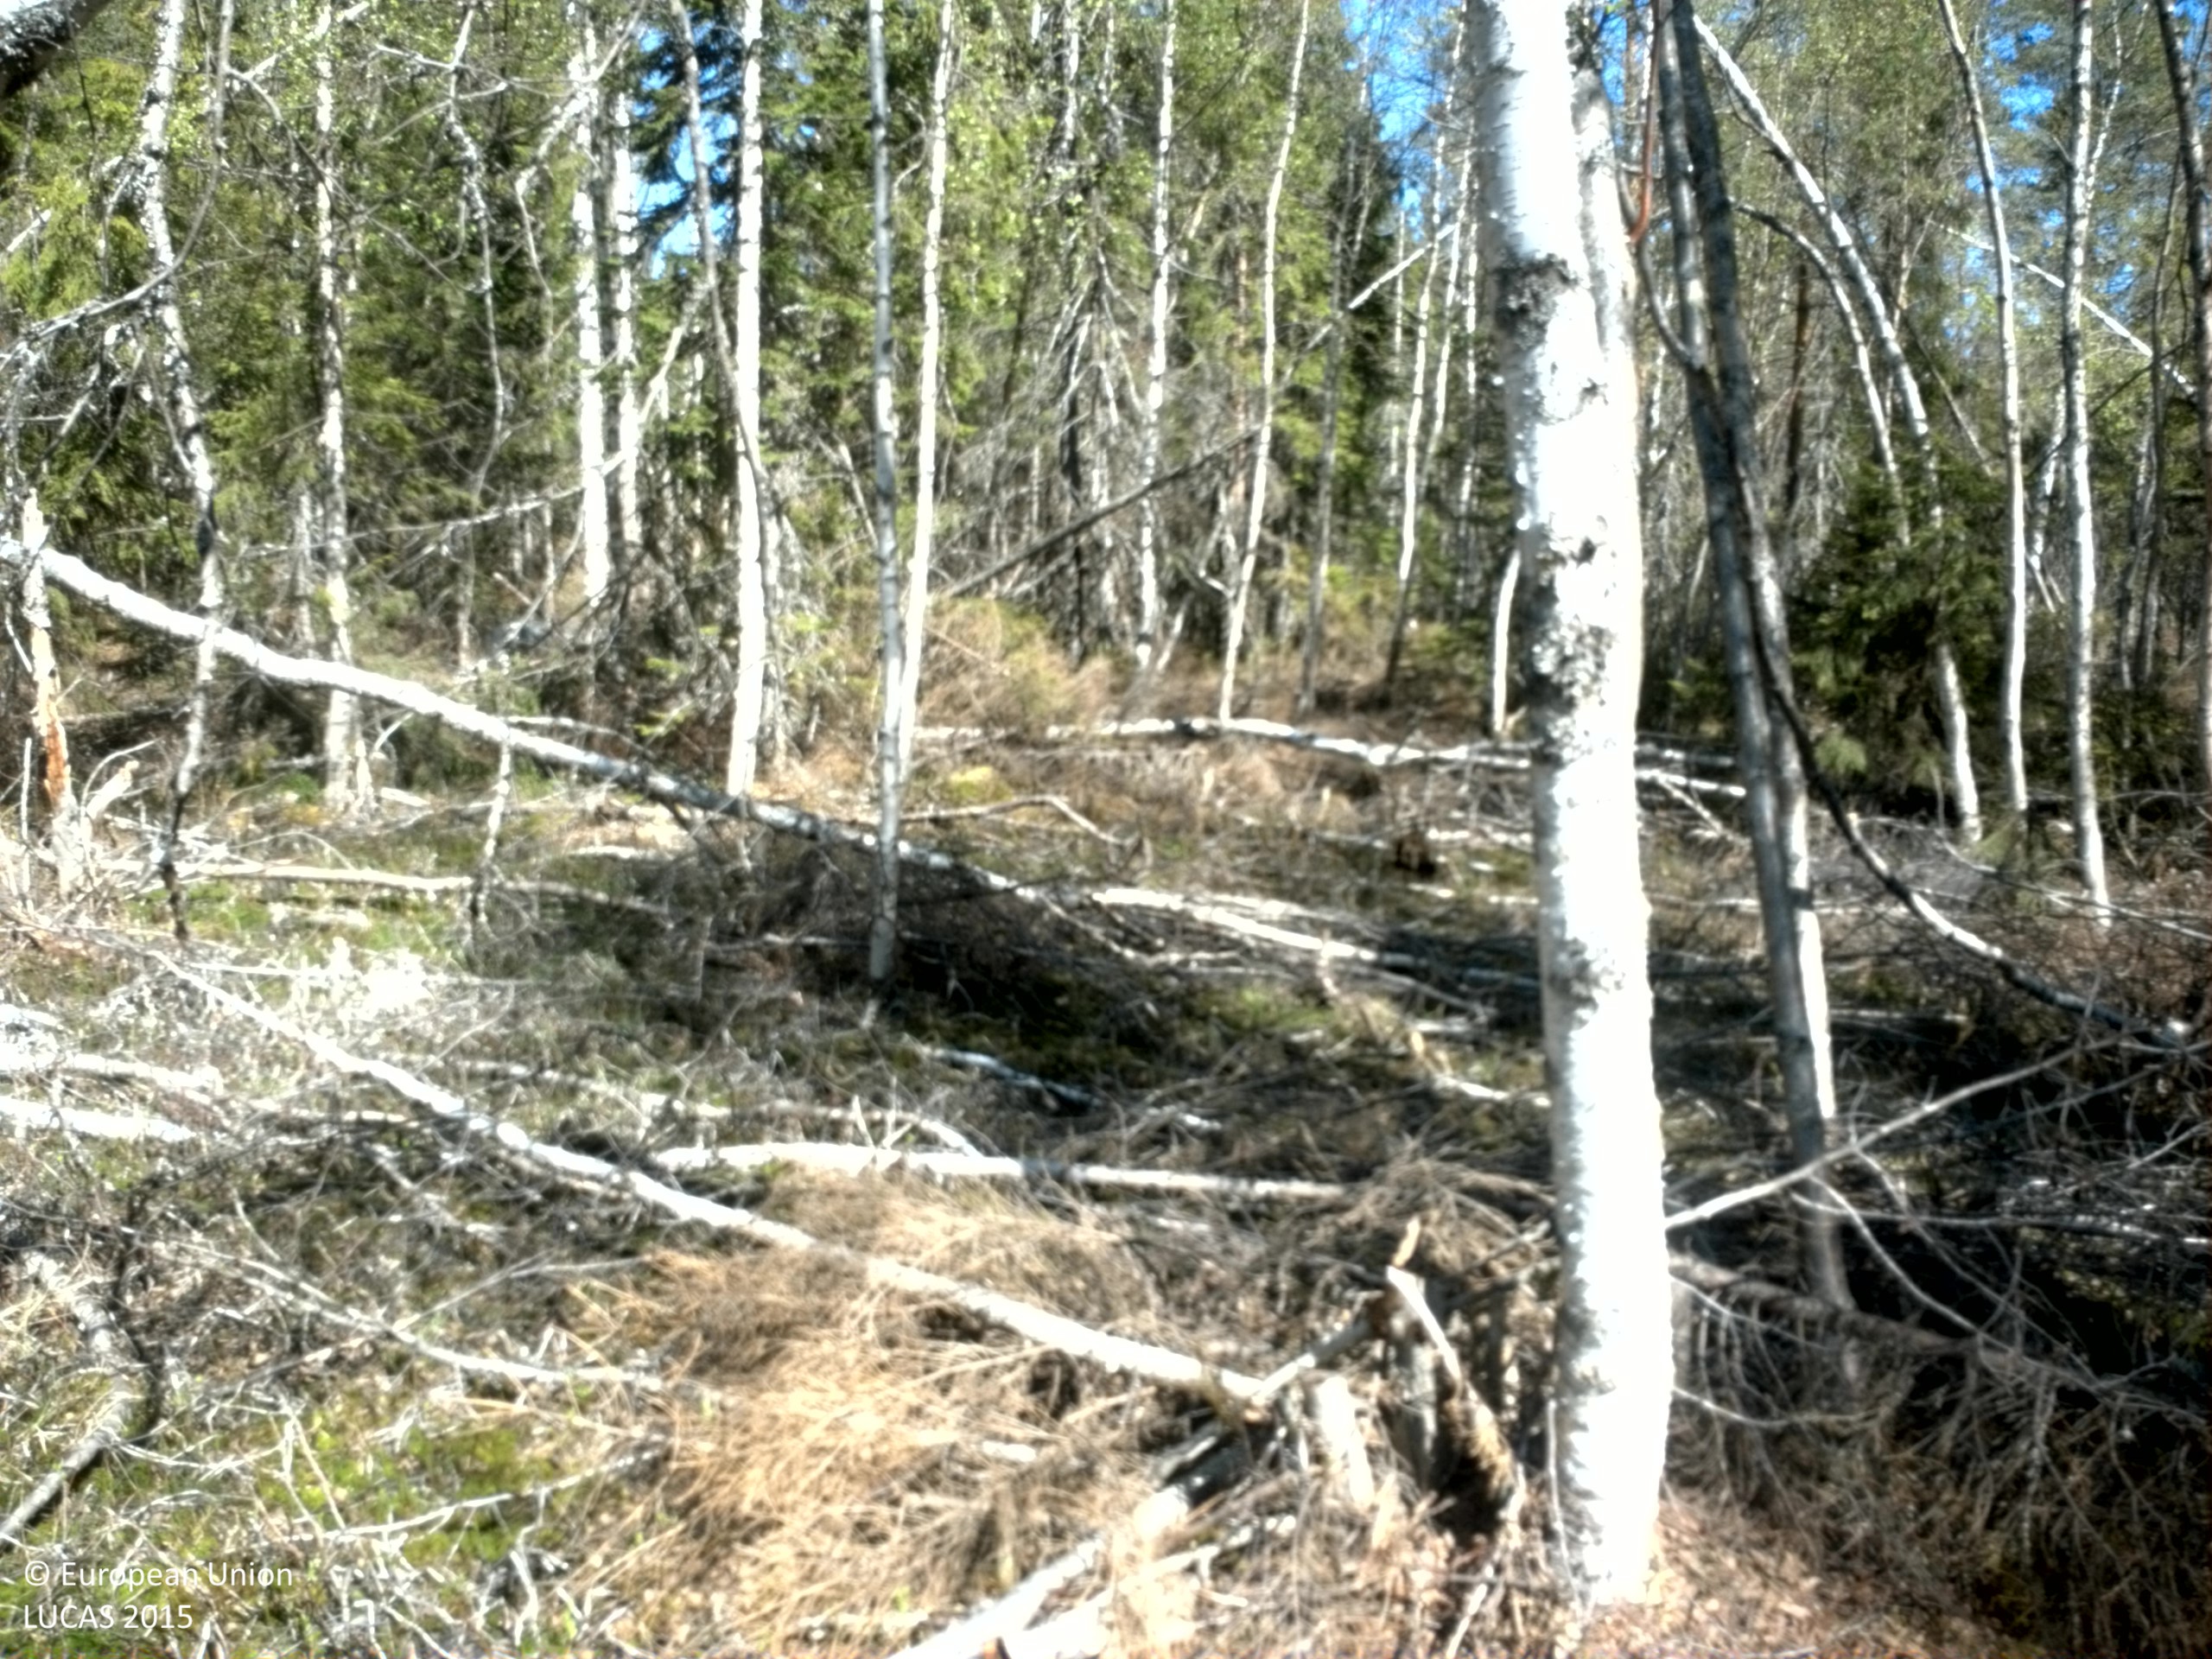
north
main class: Woodland
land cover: Spruce dominated mixed woodland
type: boreal forest
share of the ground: 10 - 25 %
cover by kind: shrubs 20 %, unconsolidated bare surface 20 %, lichens and mosses 15 %, broadleaved forest trees 10 %, coniferous forest trees 5 %
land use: Forestry
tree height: > 5 m
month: May
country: SE
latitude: 63.0690
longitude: 18.0324
